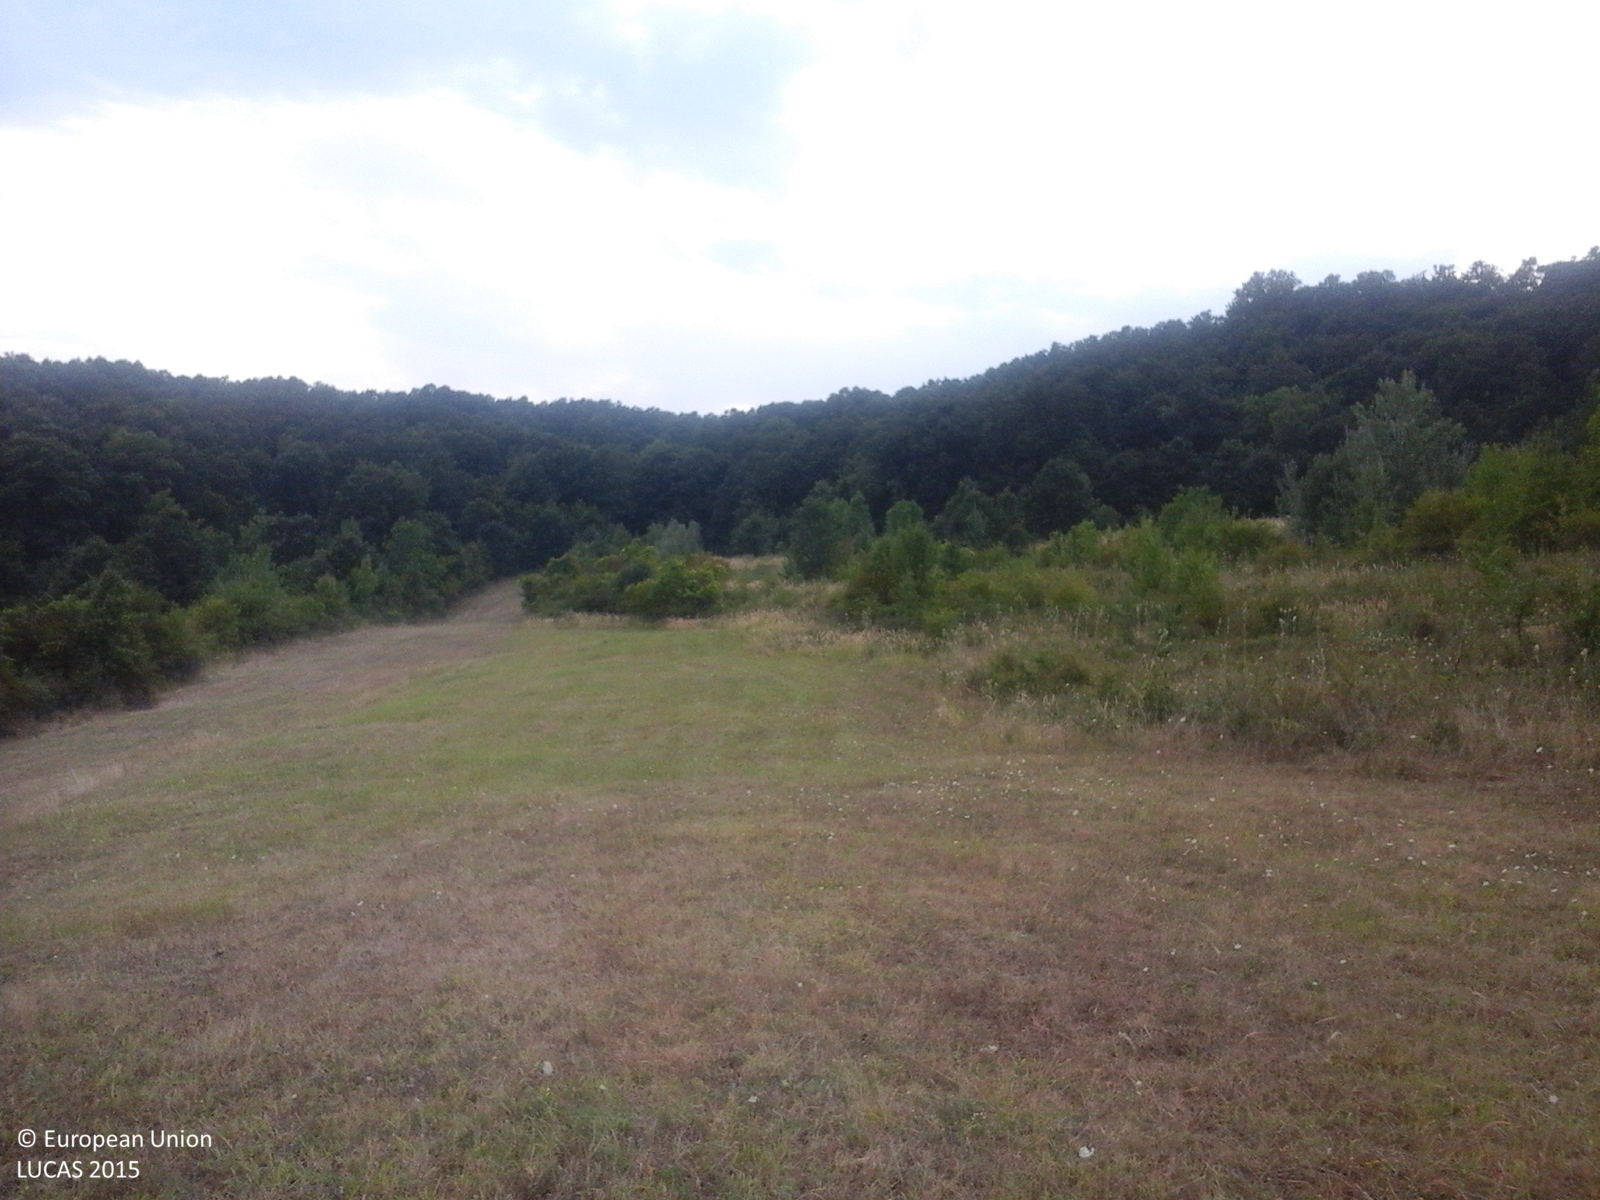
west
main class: Grassland
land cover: Grassland without tree/shrub cover
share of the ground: > 75 %
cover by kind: herbaceous plants 100 %
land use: Agriculture (excluding fallow land and kitchen gardens)
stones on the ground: < 10 %
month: August
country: RO
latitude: 44.6718
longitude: 23.0527
